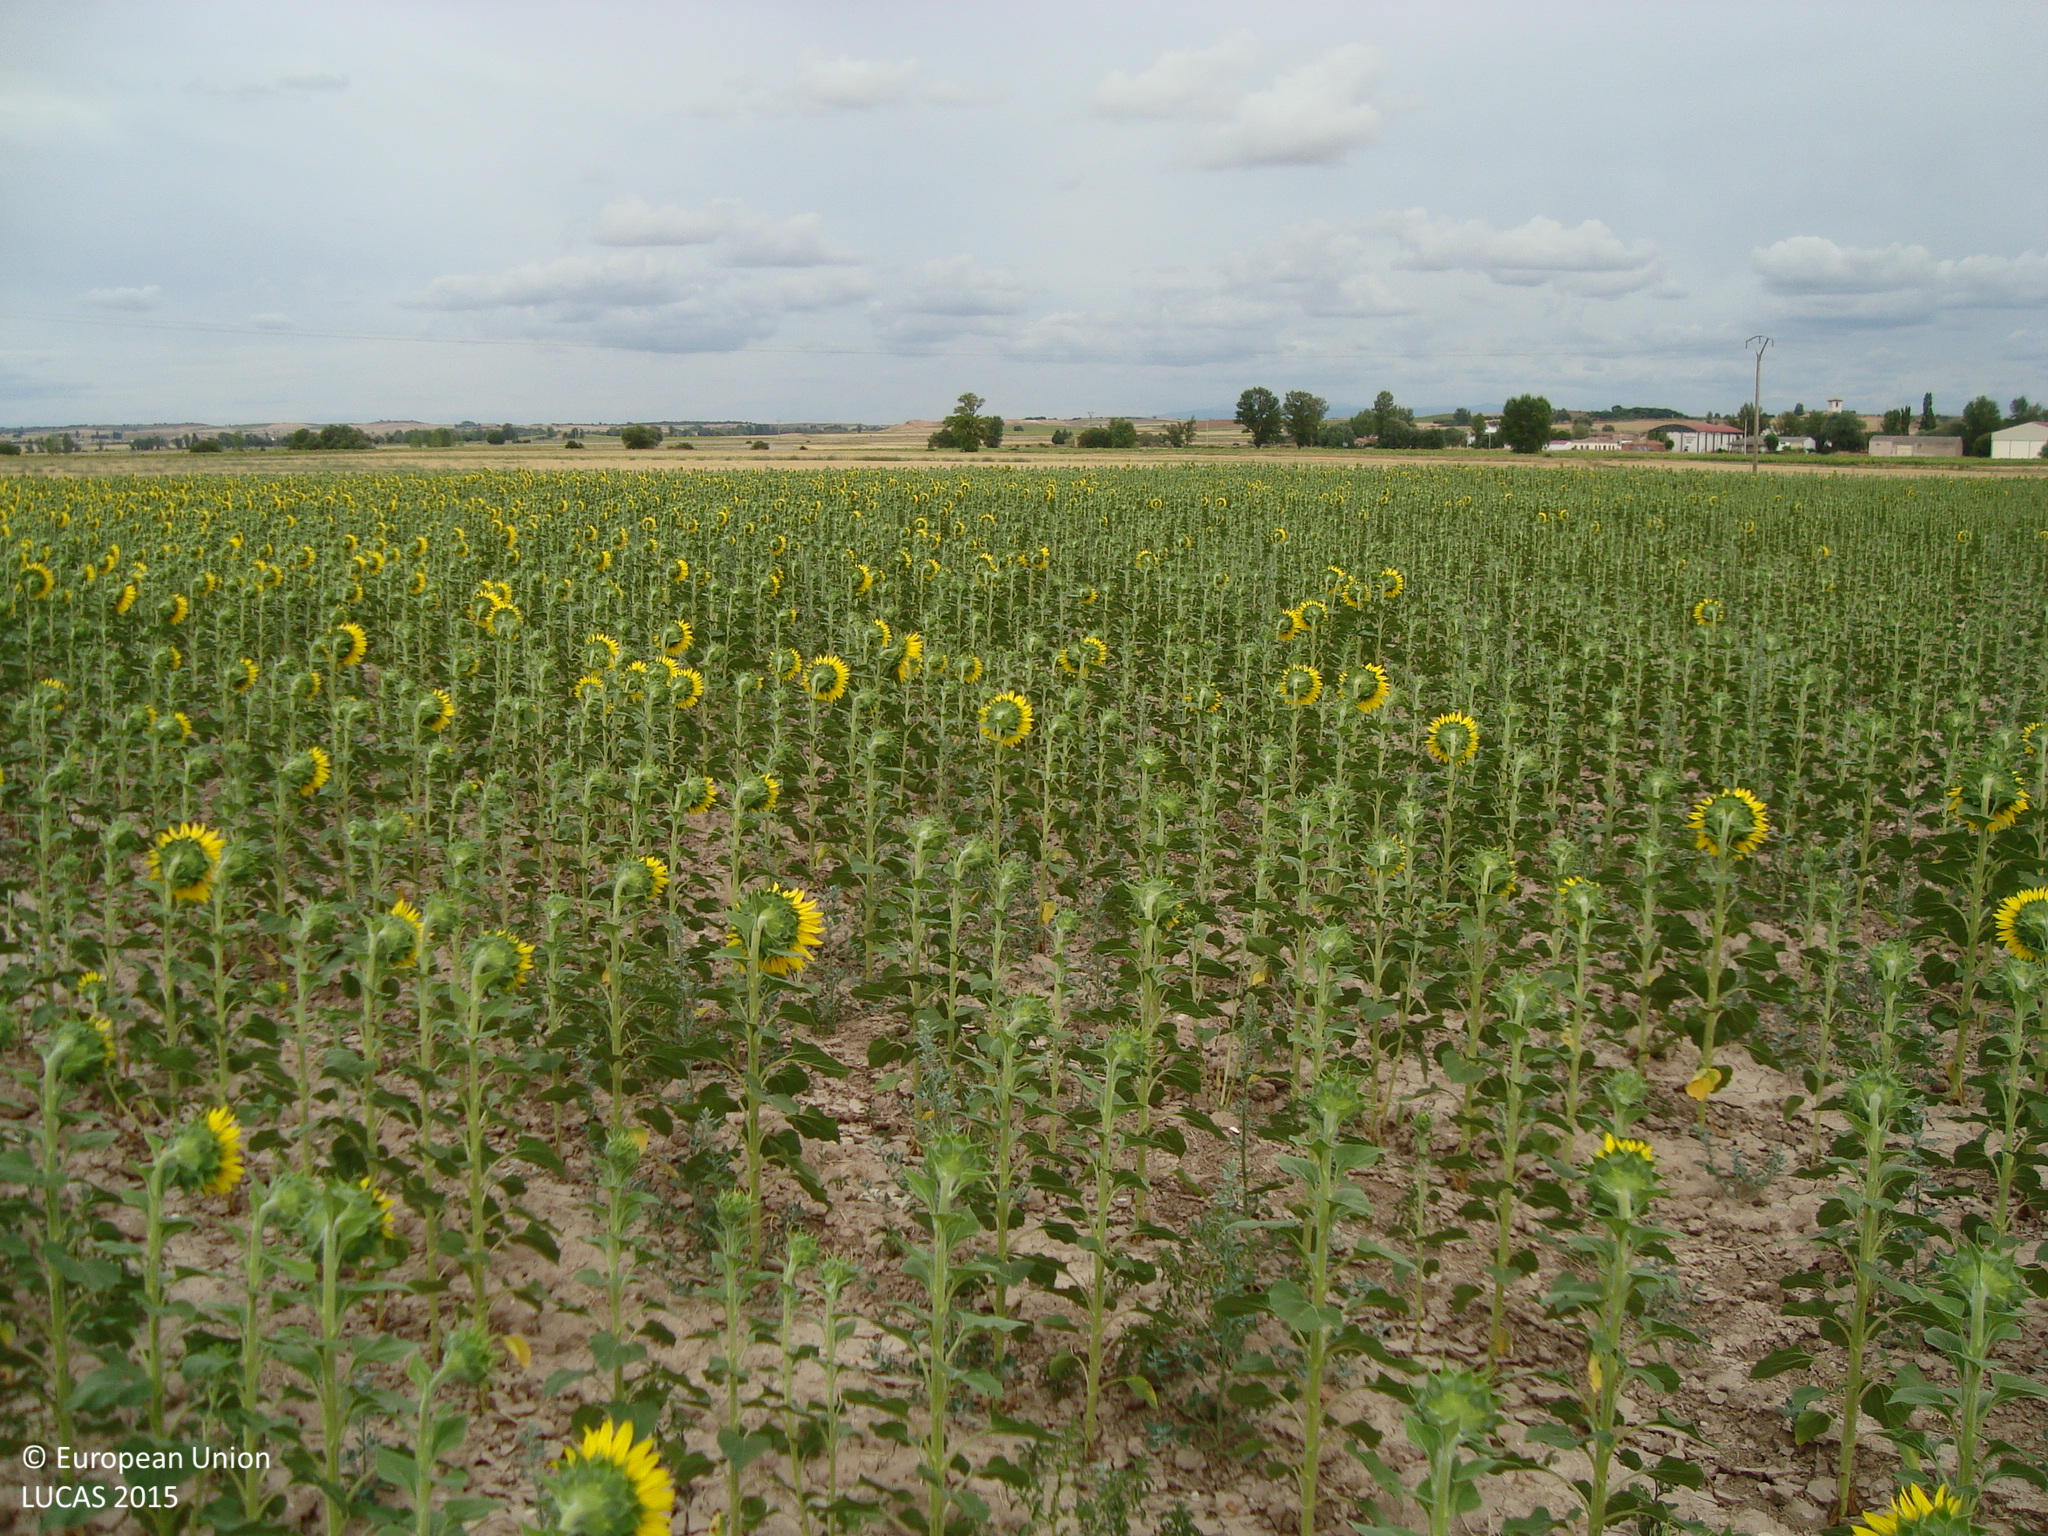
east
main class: Cropland
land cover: Sunflower
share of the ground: 50 - 75 %
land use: Agriculture (excluding fallow land and kitchen gardens)
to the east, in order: Sunflower; Grass margins; Tracks; Grass margins; Common wheat; Electric lines; Common wheat
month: August
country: ES
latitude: 42.1599
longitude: -3.9446
